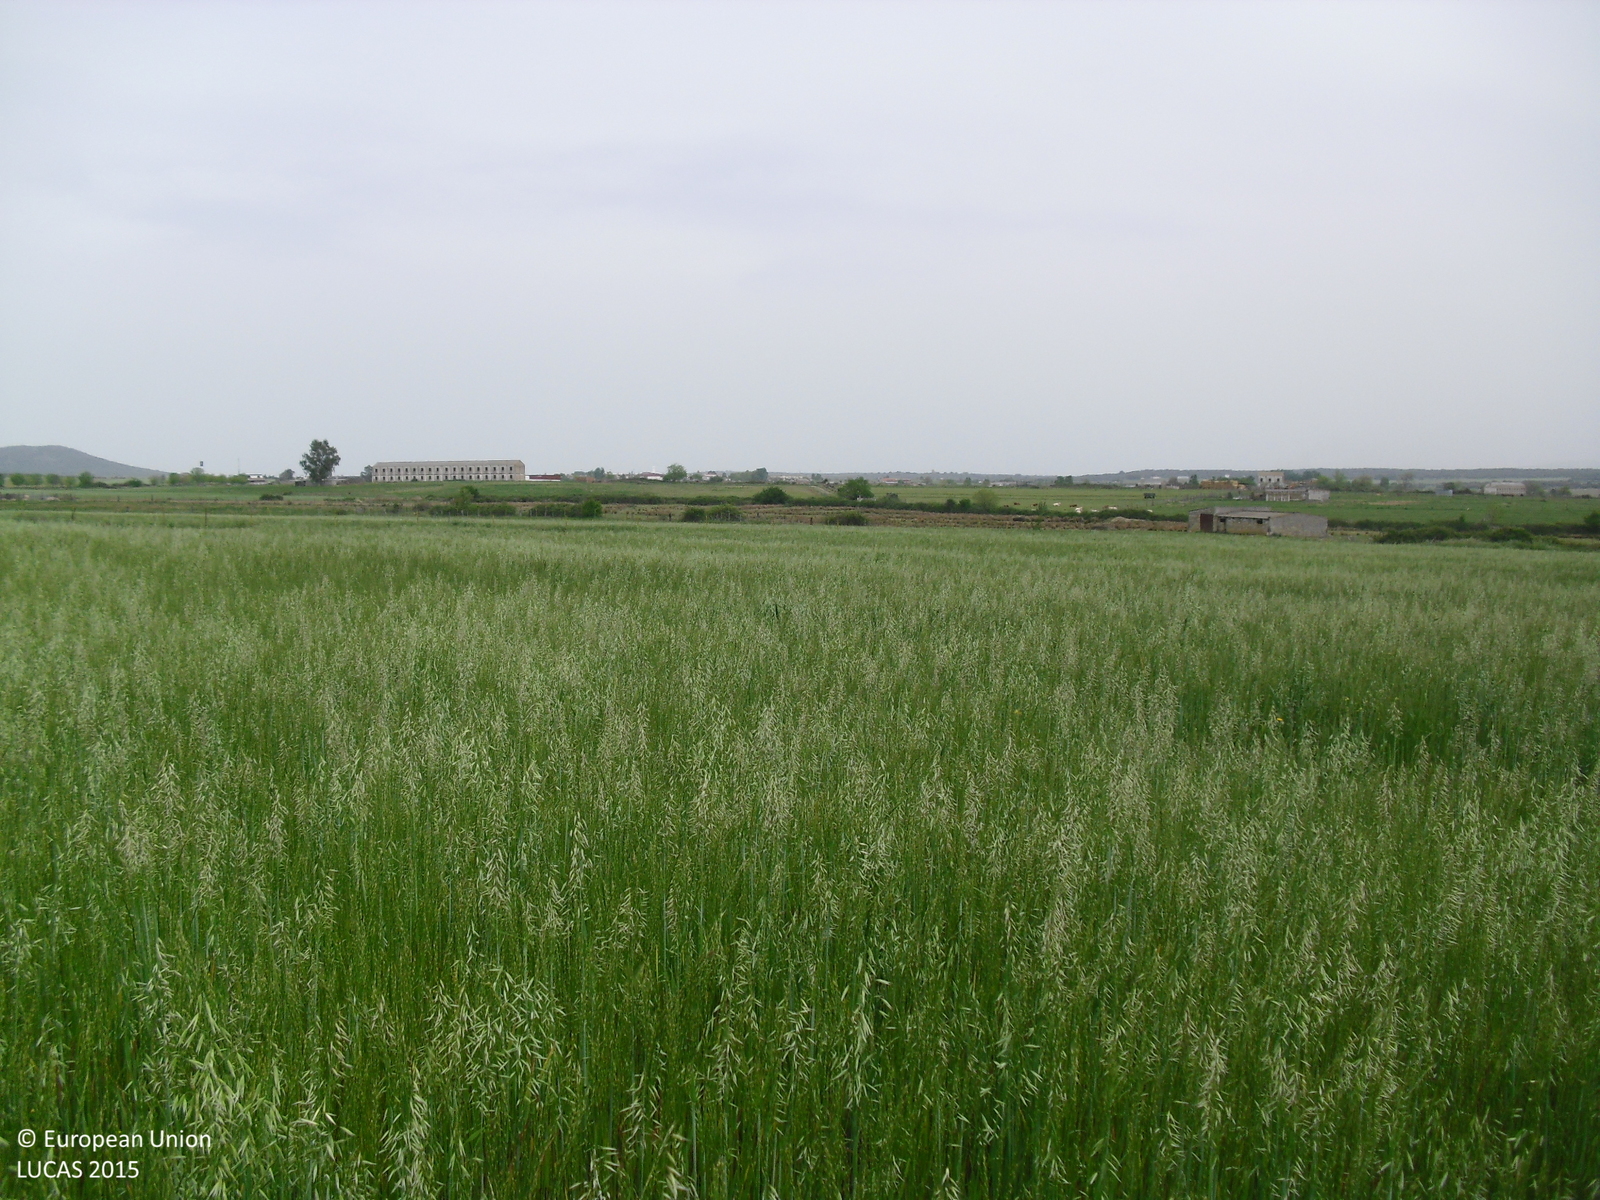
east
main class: Cropland
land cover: Oats
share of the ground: > 75 %
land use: Agriculture (excluding fallow land and kitchen gardens)
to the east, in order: Oats; Fences; Oats; Fences; Tracks; Fences; Tracks; Fences; Grassland without tree/shrub cover; Fences; Grassland without tree/shrub cover
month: April
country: ES
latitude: 39.3780
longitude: -6.3766
